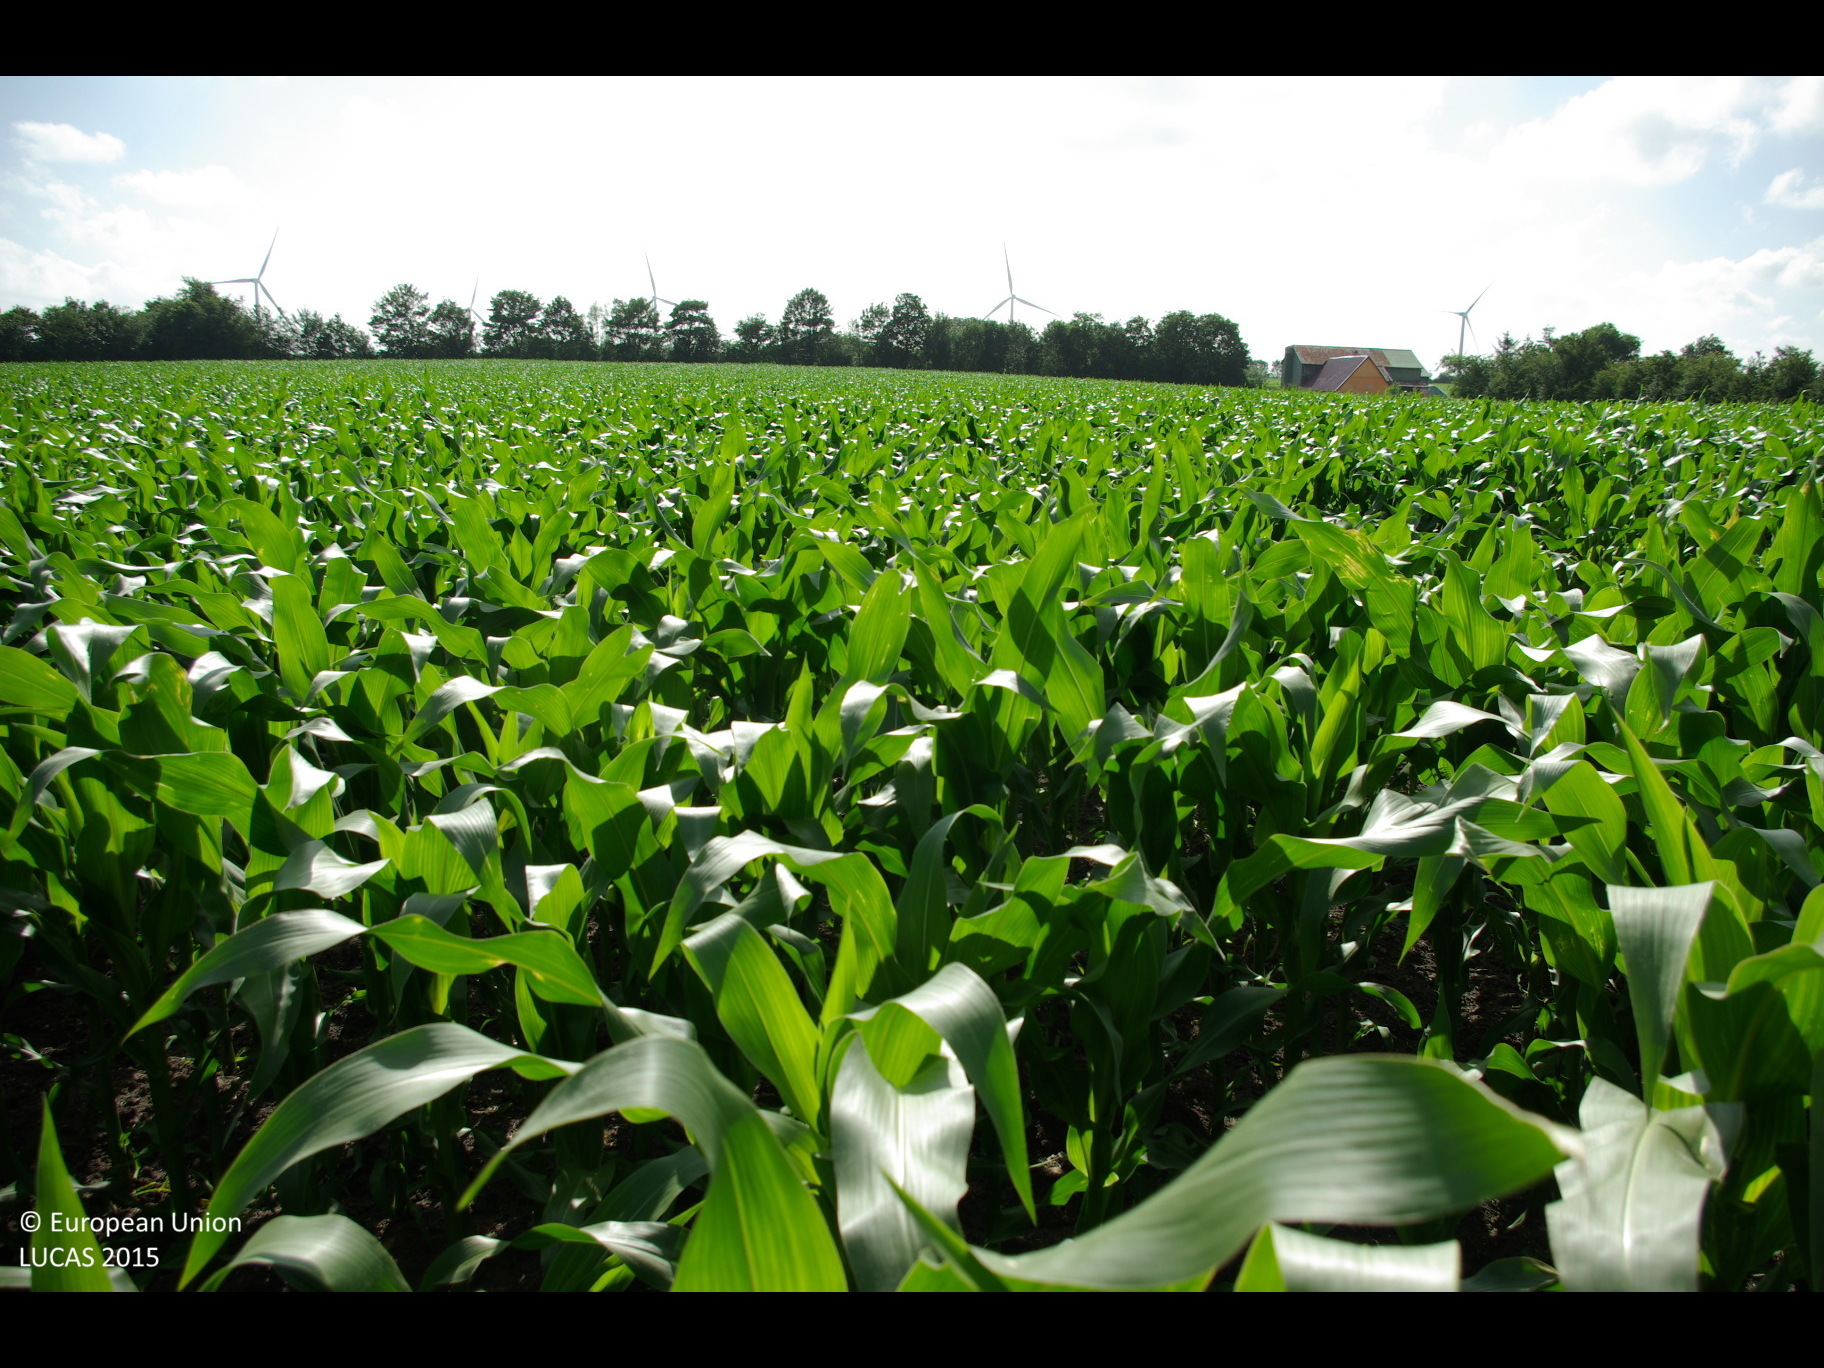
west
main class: Cropland
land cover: Maize
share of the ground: > 75 %
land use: Agriculture (excluding fallow land and kitchen gardens)
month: July
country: DE
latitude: 54.6397
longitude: 9.2413
